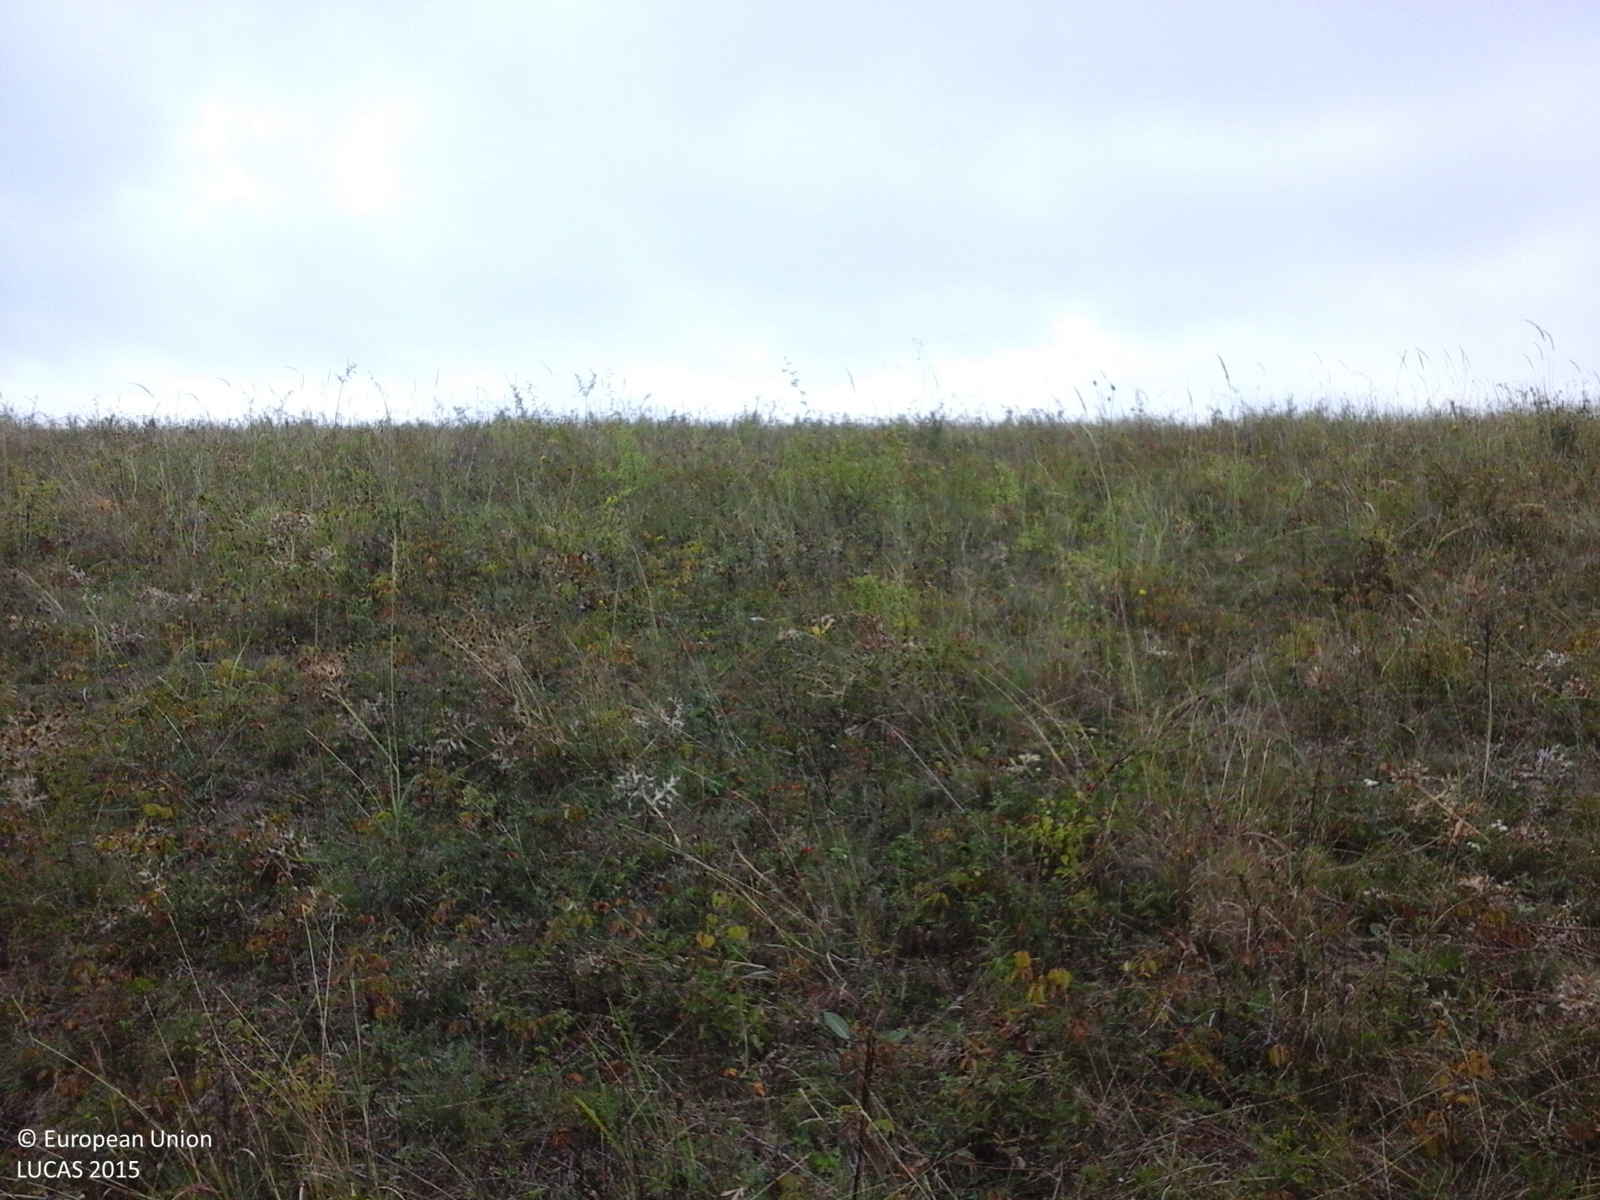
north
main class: Grassland
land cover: Grassland without tree/shrub cover
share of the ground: > 75 %
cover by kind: herbaceous plants 100 %
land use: Agriculture (excluding fallow land and kitchen gardens)
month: September
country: RO
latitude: 45.8927
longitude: 21.9875
